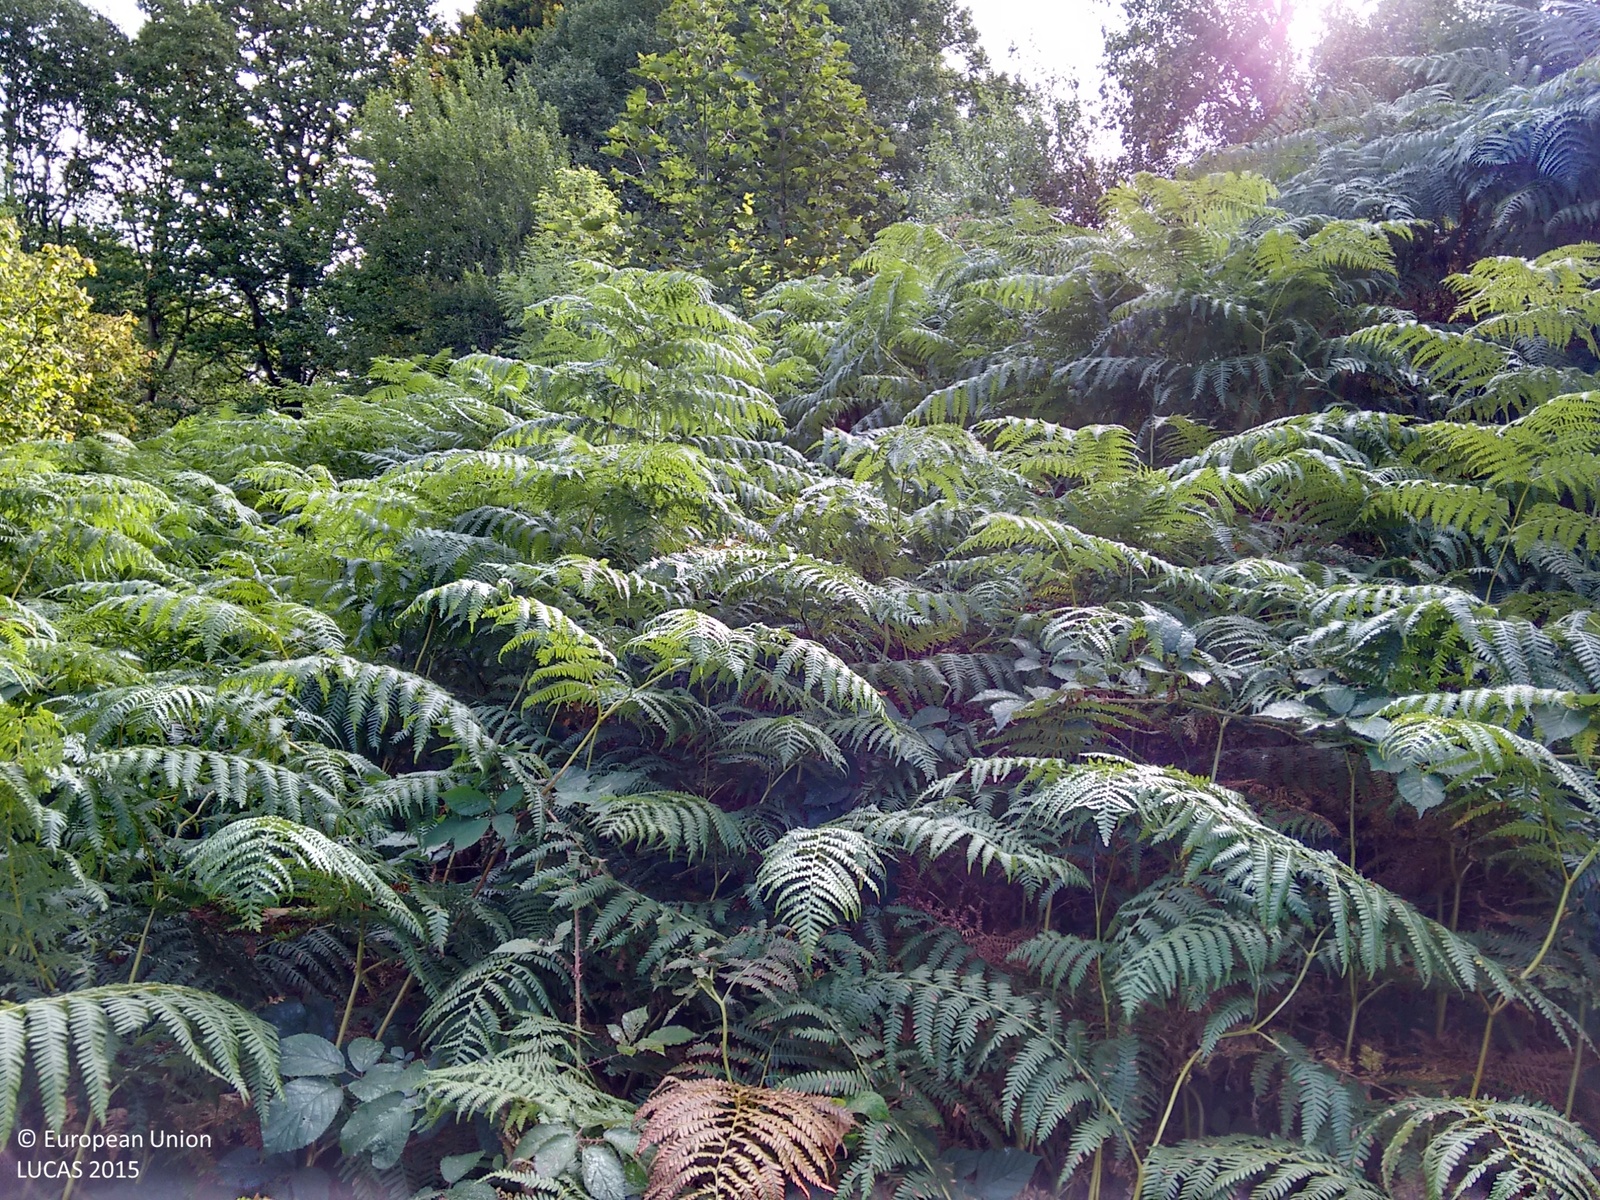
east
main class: Grassland
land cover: Grassland with sparse tree/shrub cover
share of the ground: > 75 %
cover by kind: herbaceous plants 95 %, broadleaved forest trees 5 %
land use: Semi-natural and natural areas not in use
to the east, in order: Grassland with sparse tree/shrub cover; Broadleaved woodland; Managed hedges; Fences; Paved roads, cycling and walking lanes; Fences; Broadleaved woodland
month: September
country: GB
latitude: 51.8160
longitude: -3.0593
